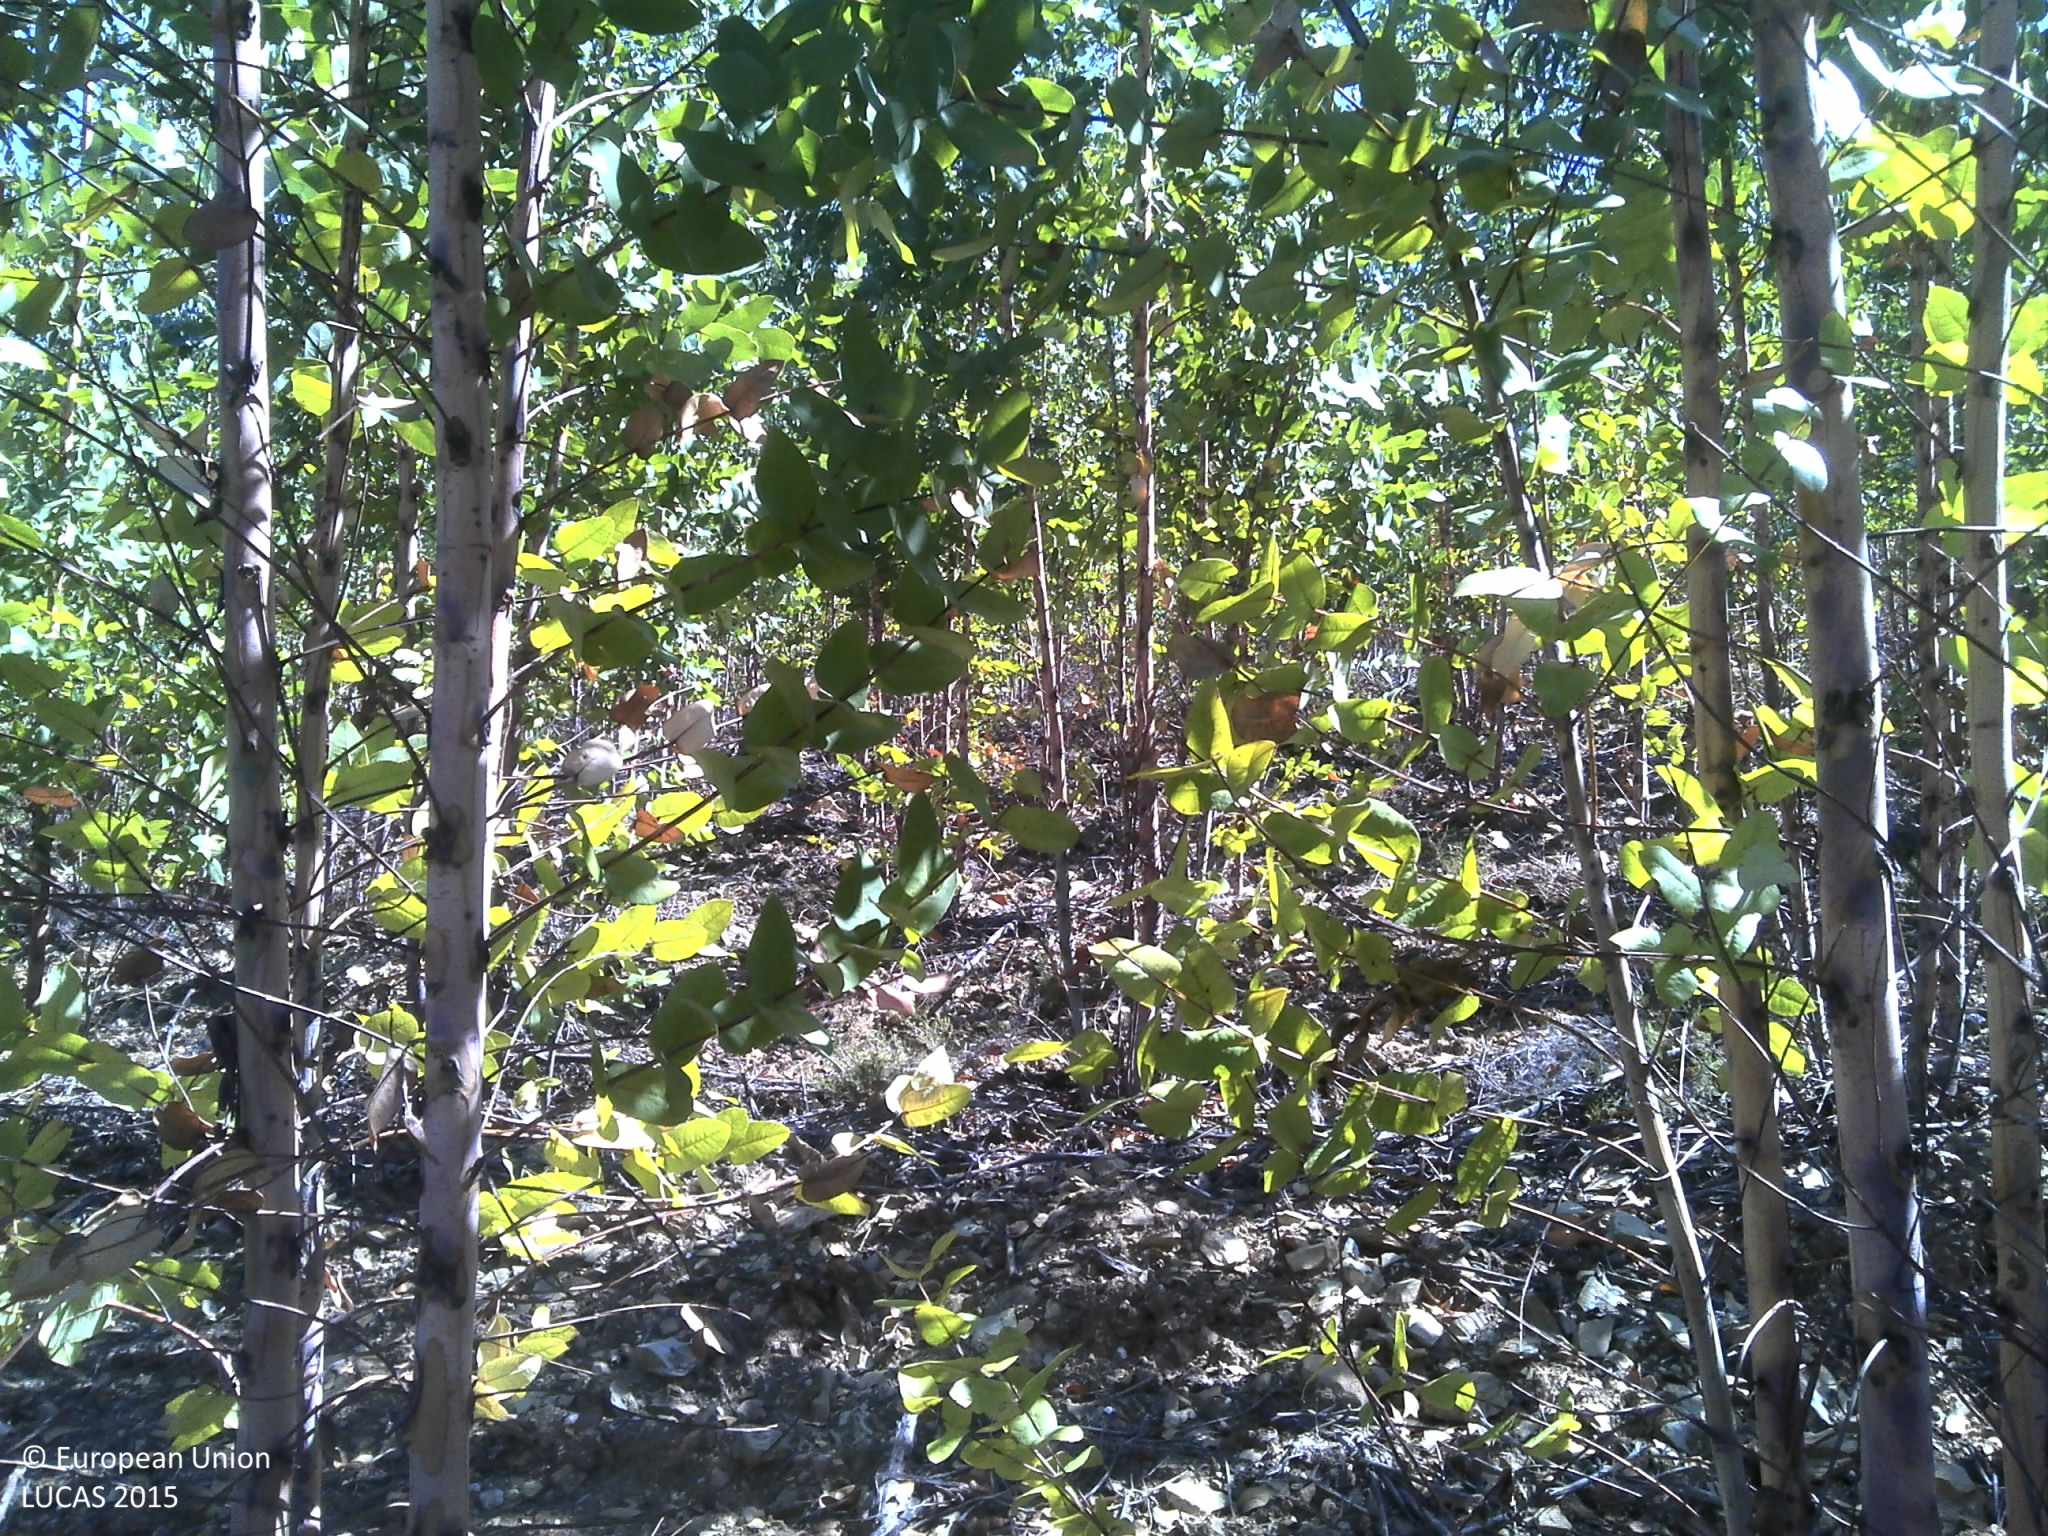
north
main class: Woodland
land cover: Broadleaved woodland
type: exotic forest
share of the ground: 25 - 50 %
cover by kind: broadleaved forest trees 50 %, unconsolidated bare surface 45 %, shrubs 5 %
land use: Forestry
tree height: > 5 m
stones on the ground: 10 - 25 %
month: July
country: PT
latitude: 40.0283
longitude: -7.6005
